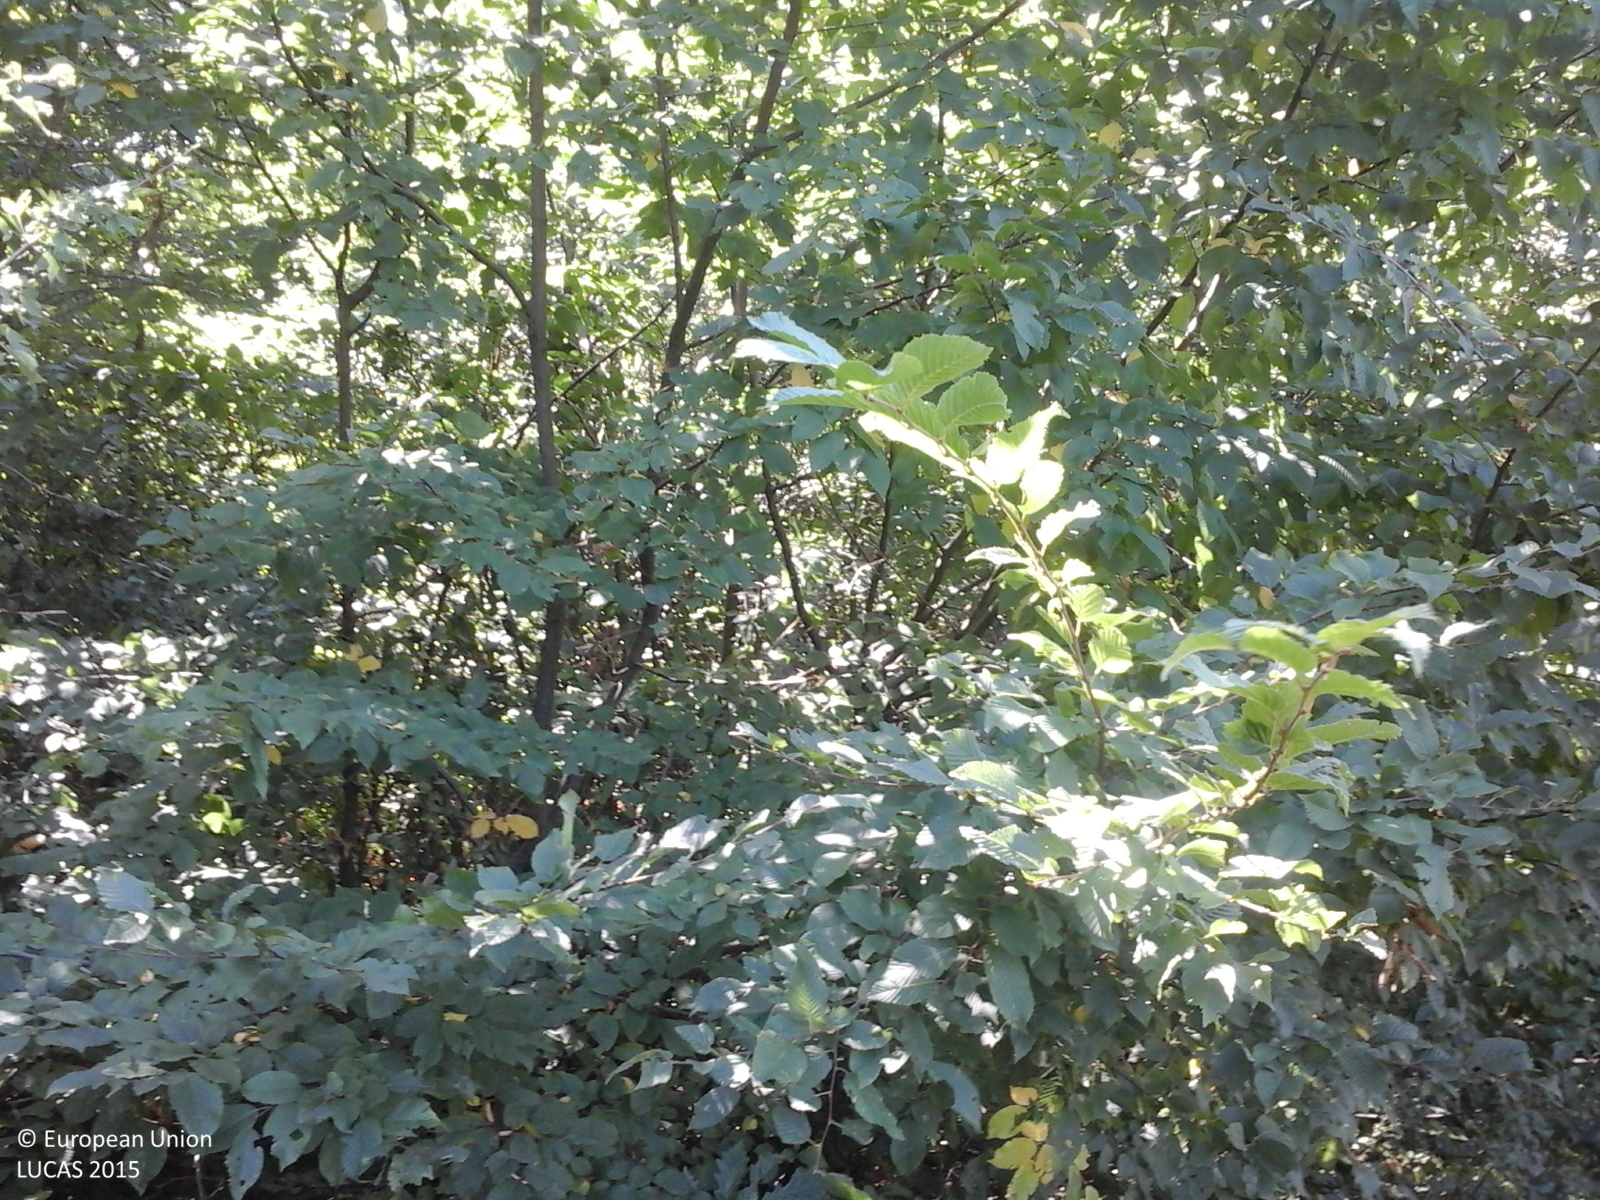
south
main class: Woodland
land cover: Broadleaved woodland
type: beech forest
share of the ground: > 75 %
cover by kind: broadleaved forest trees 100 %
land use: Forestry
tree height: > 5 m
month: September
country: RO
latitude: 47.3717
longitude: 23.4881
